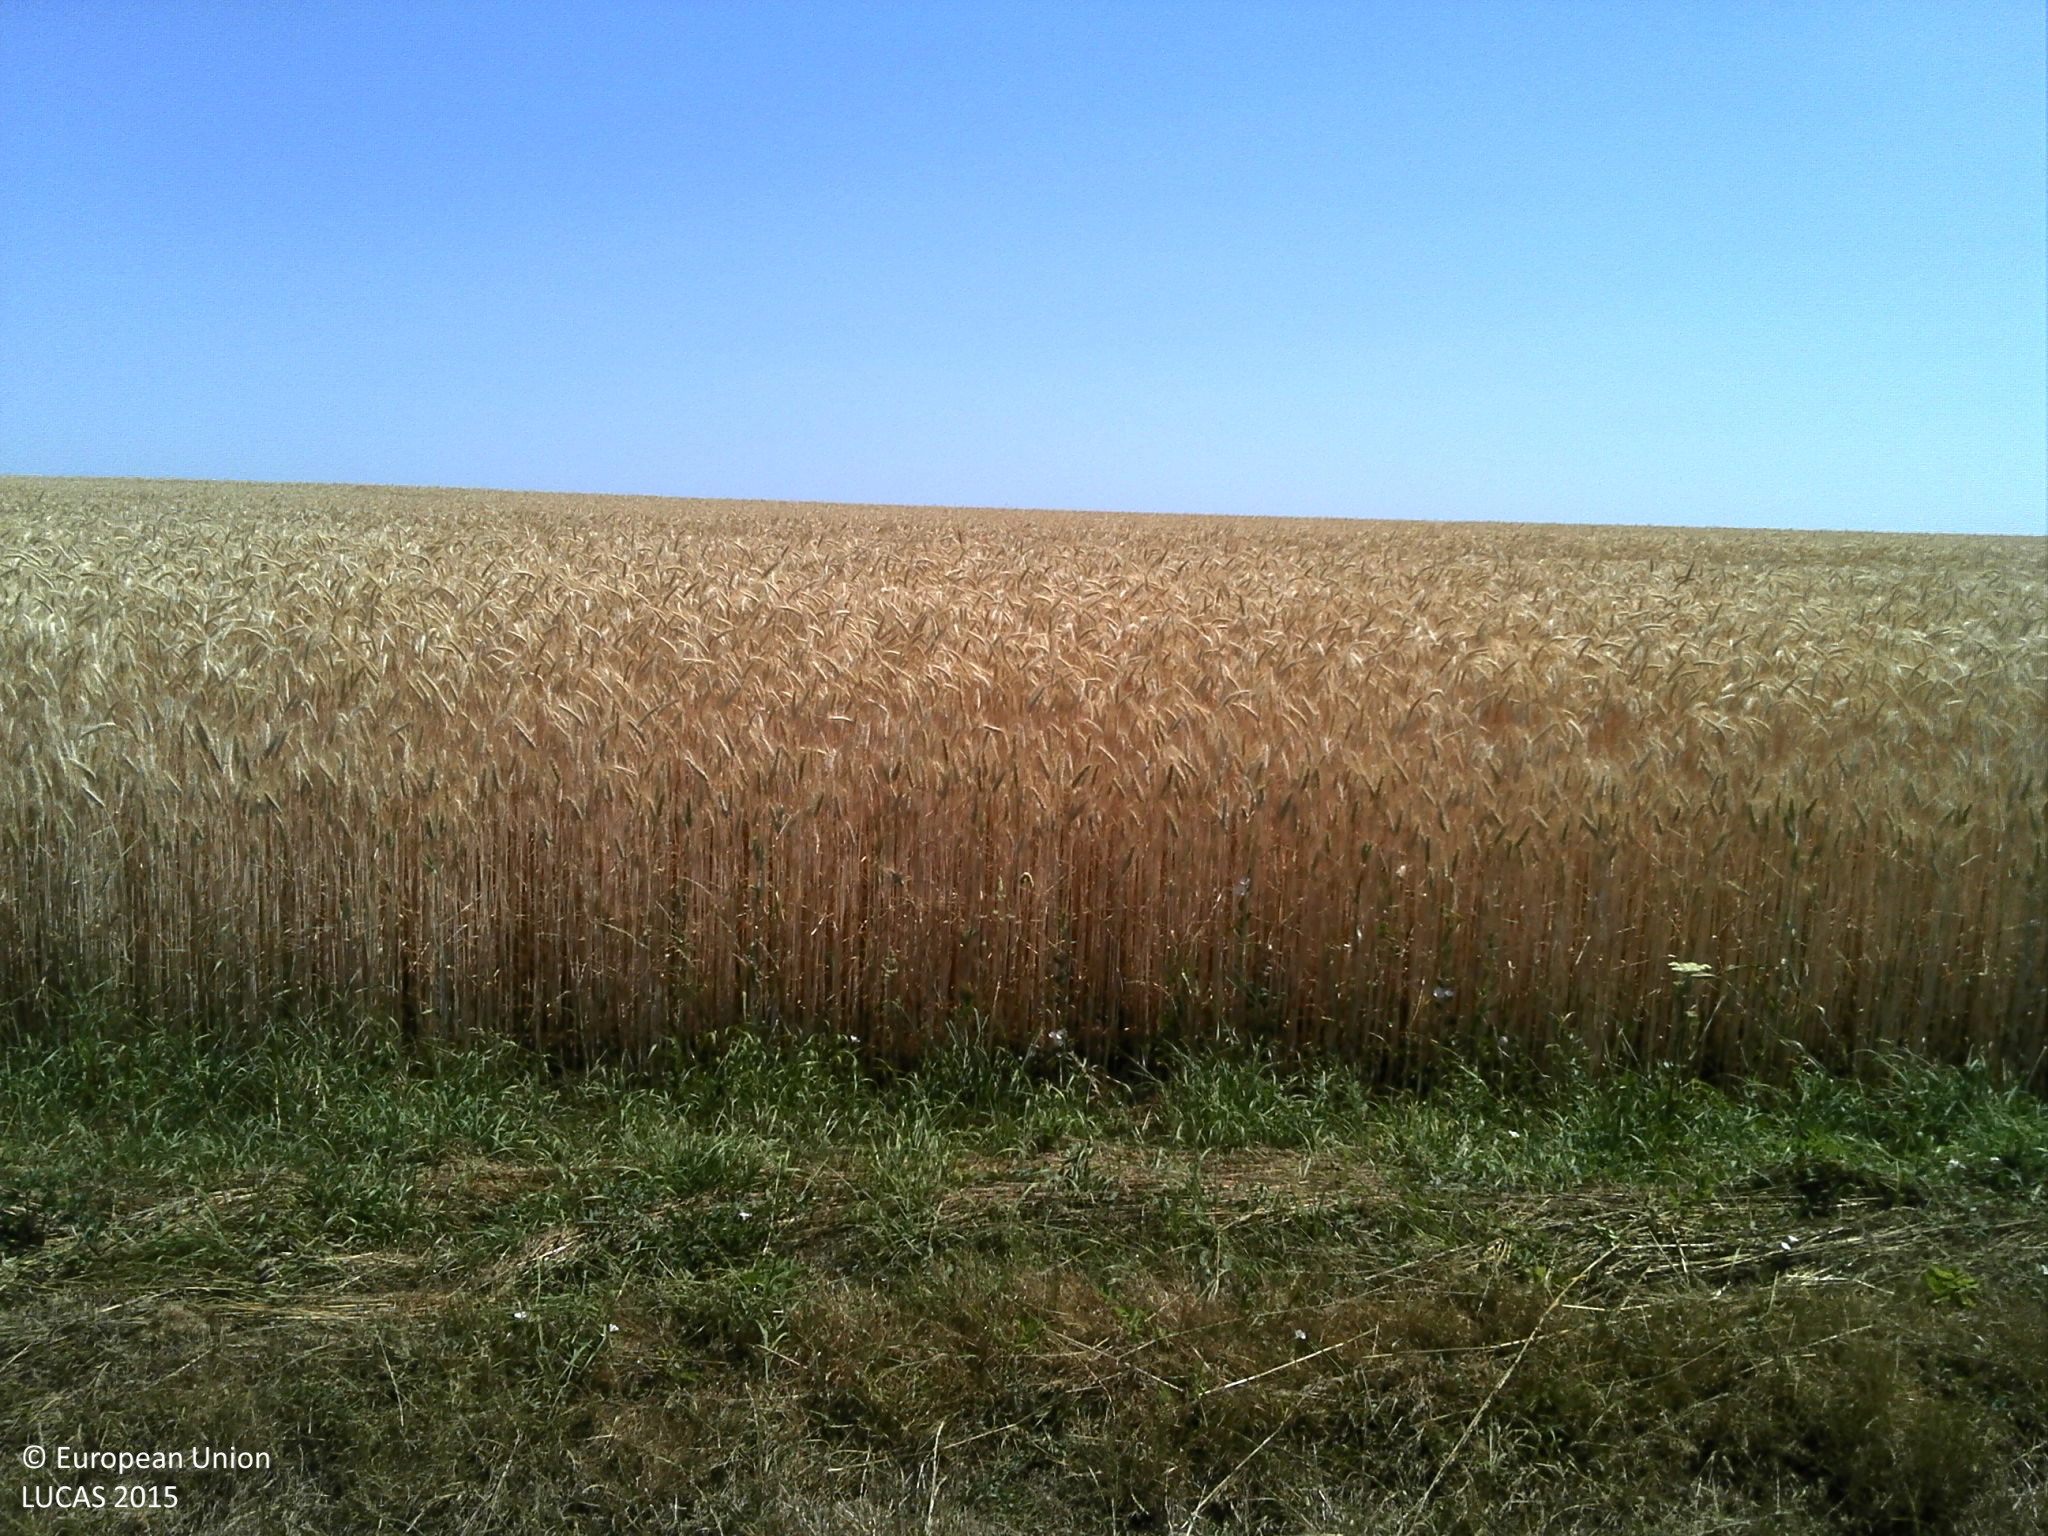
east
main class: Cropland
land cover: Rape and turnip rape
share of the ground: > 75 %
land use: Agriculture (excluding fallow land and kitchen gardens)
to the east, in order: Rape and turnip rape; Grass margins; Tracks; Grass margins; Triticale; Grass margins; Rape and turnip rape
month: July
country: FR
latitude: 49.4730
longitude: 6.2045
